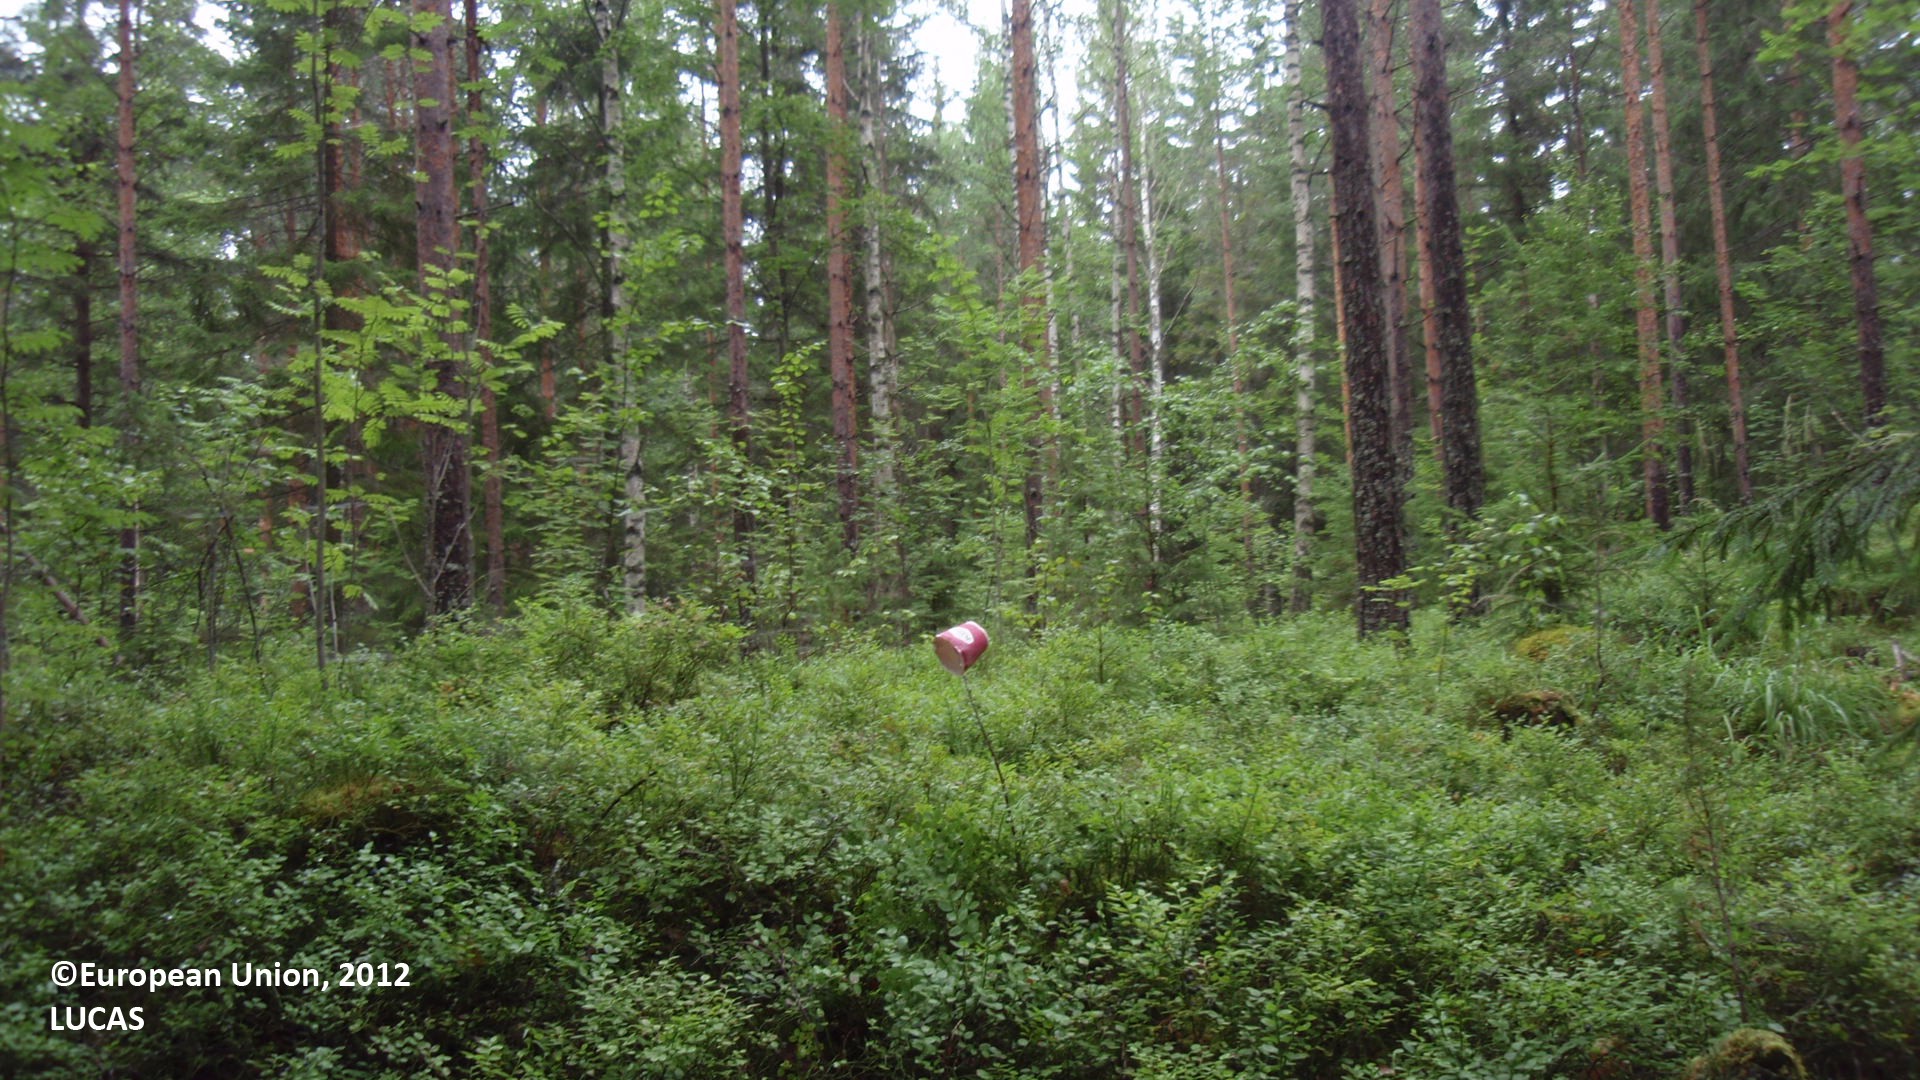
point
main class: Woodland
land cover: Pine dominated coniferous woodland
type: boreal forest
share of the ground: 25 - 50 %
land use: Forestry
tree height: > 5 m
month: July
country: FI
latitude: 61.5199
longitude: 27.3354
